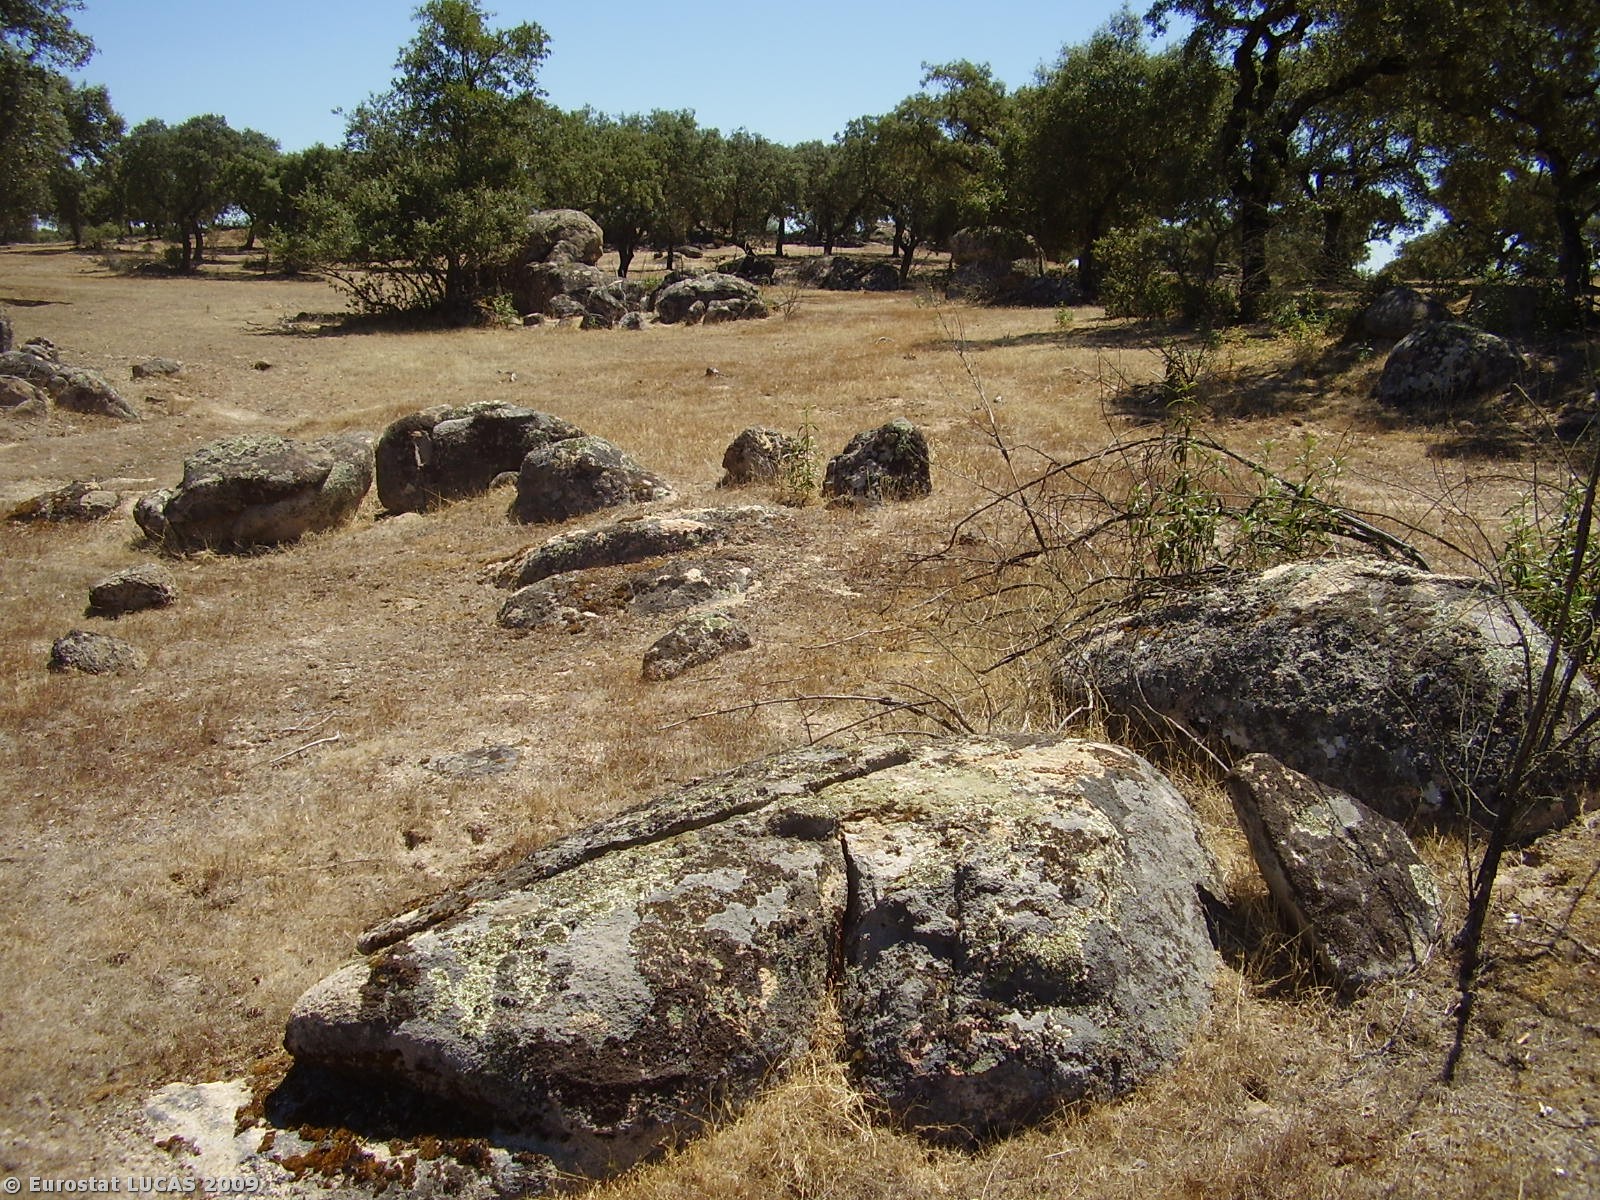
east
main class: Woodland
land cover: Broadleaved woodland
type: broadleaved evergreen forest
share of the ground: 10 - 25 %
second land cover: Grassland with sparse tree/shrub cover
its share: 50 - 75 %
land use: Forestry
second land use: Agriculture (excluding fallow land and kitchen gardens)
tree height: > 5 m
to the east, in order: Broadleaved woodland; Grassland with sparse tree/shrub cover; Broadleaved woodland; Rock outcrops; Broadleaved woodland; Rock outcrops; Broadleaved woodland; Grassland without tree/shrub cover
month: July
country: PT
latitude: 38.8743
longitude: -7.9466
